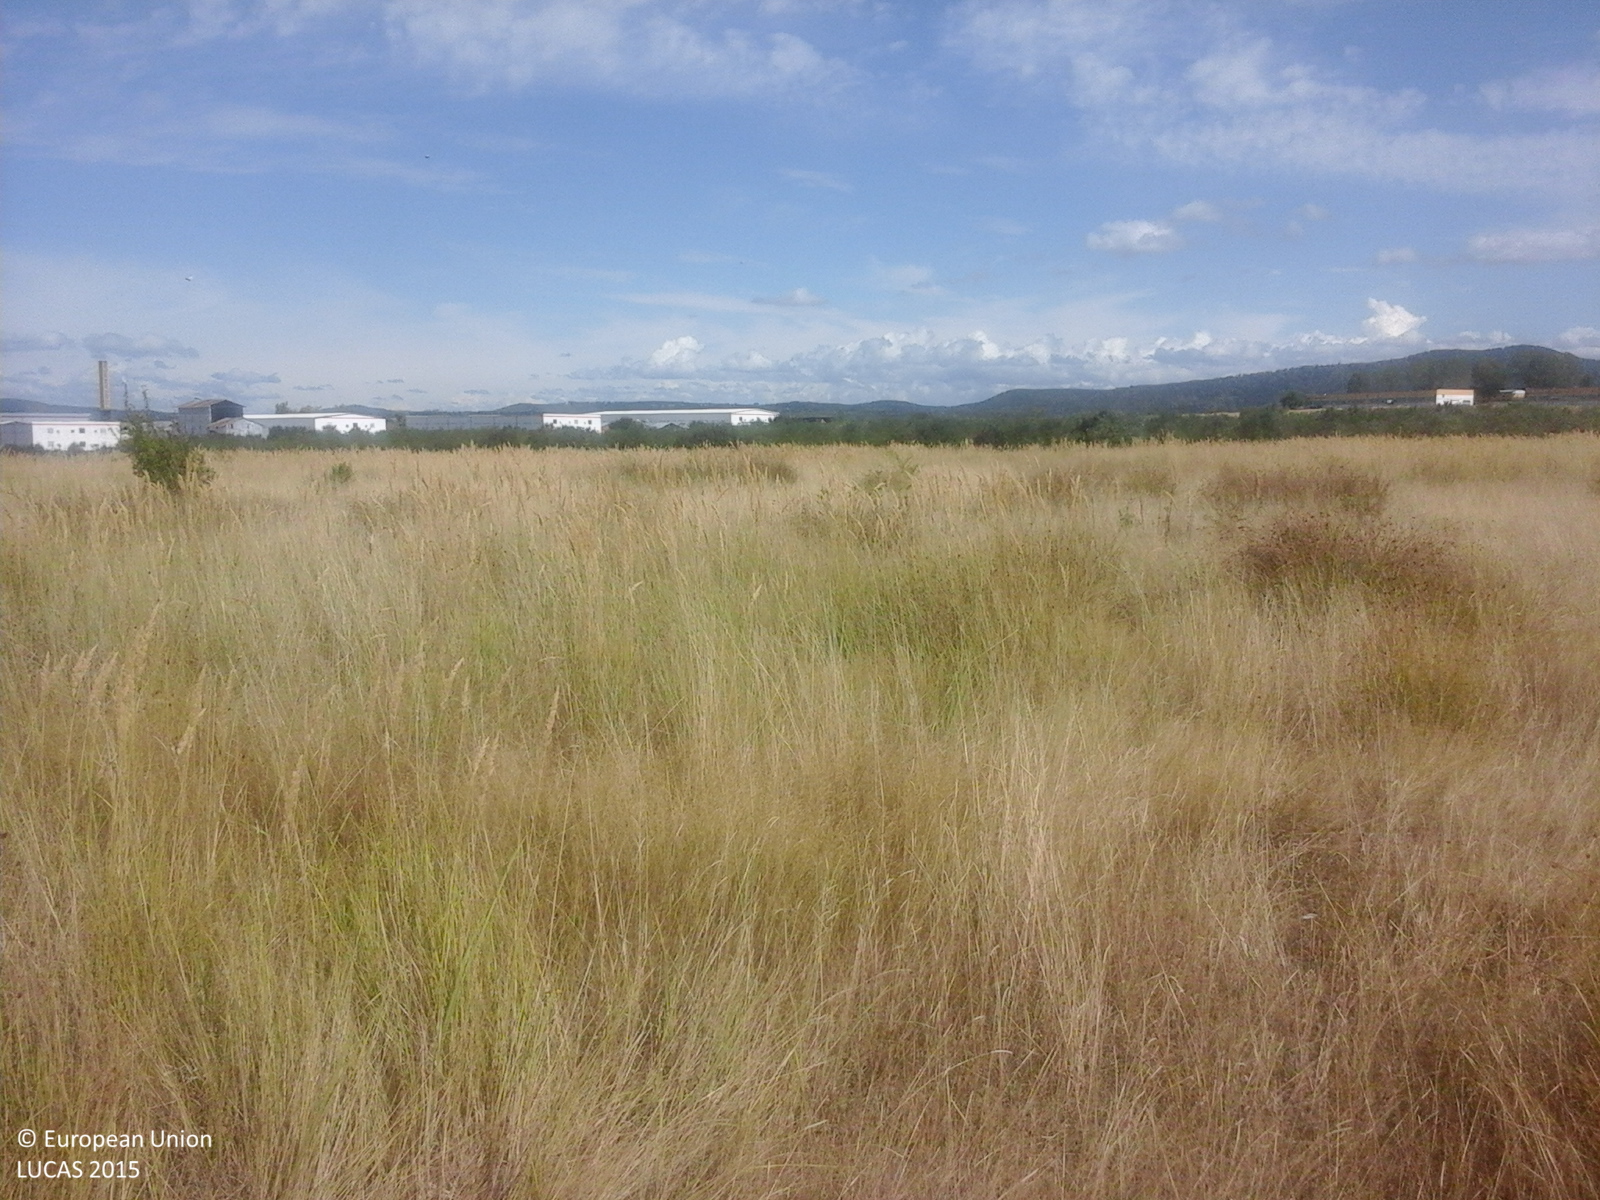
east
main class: Grassland
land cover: Spontaneously vegetated surfaces
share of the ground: > 75 %
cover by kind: herbaceous plants 100 %
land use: Fallow land
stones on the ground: < 10 %
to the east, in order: Spontaneously vegetated surfaces; Shrubland with sparse tree cover; Broadleaved woodland
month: August
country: RO
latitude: 45.3621
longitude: 21.6896
